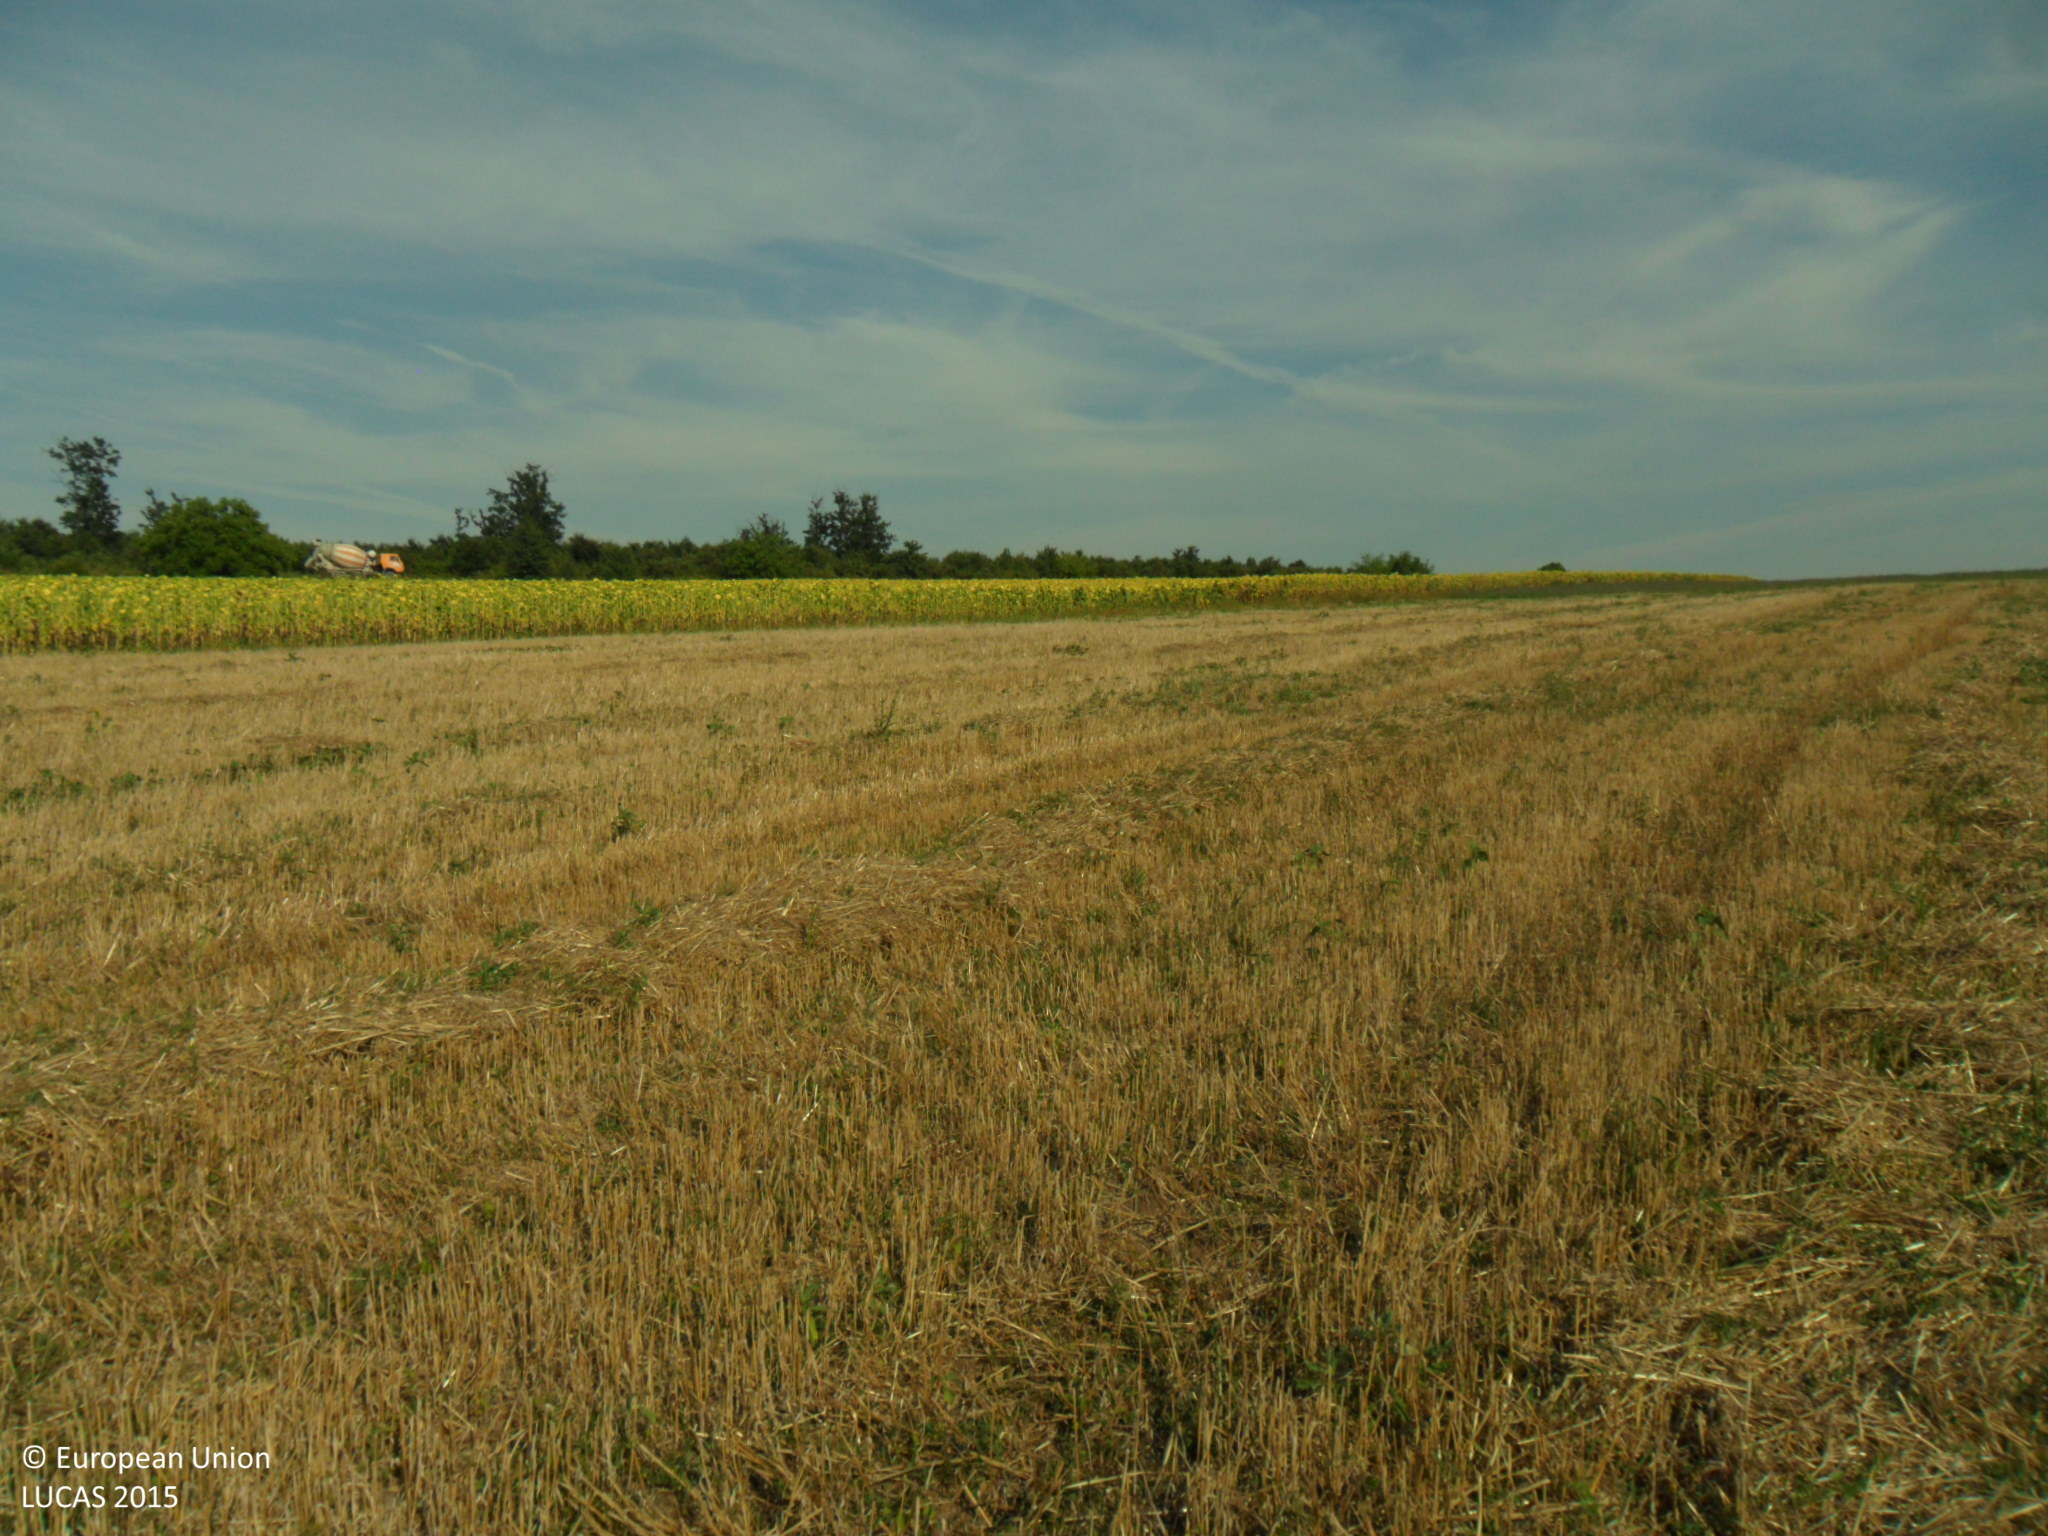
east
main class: Cropland
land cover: Barley
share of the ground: 50 - 75 %
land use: Agriculture (excluding fallow land and kitchen gardens)
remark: Harvested field
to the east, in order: Barley; Sunflower; Ditches and canals; Sunflower; Grass margins; Lines of trees; Paved roads, cycling and walking lanes; Broadleaved woodland
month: August
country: BG
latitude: 43.6376
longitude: 27.0911
